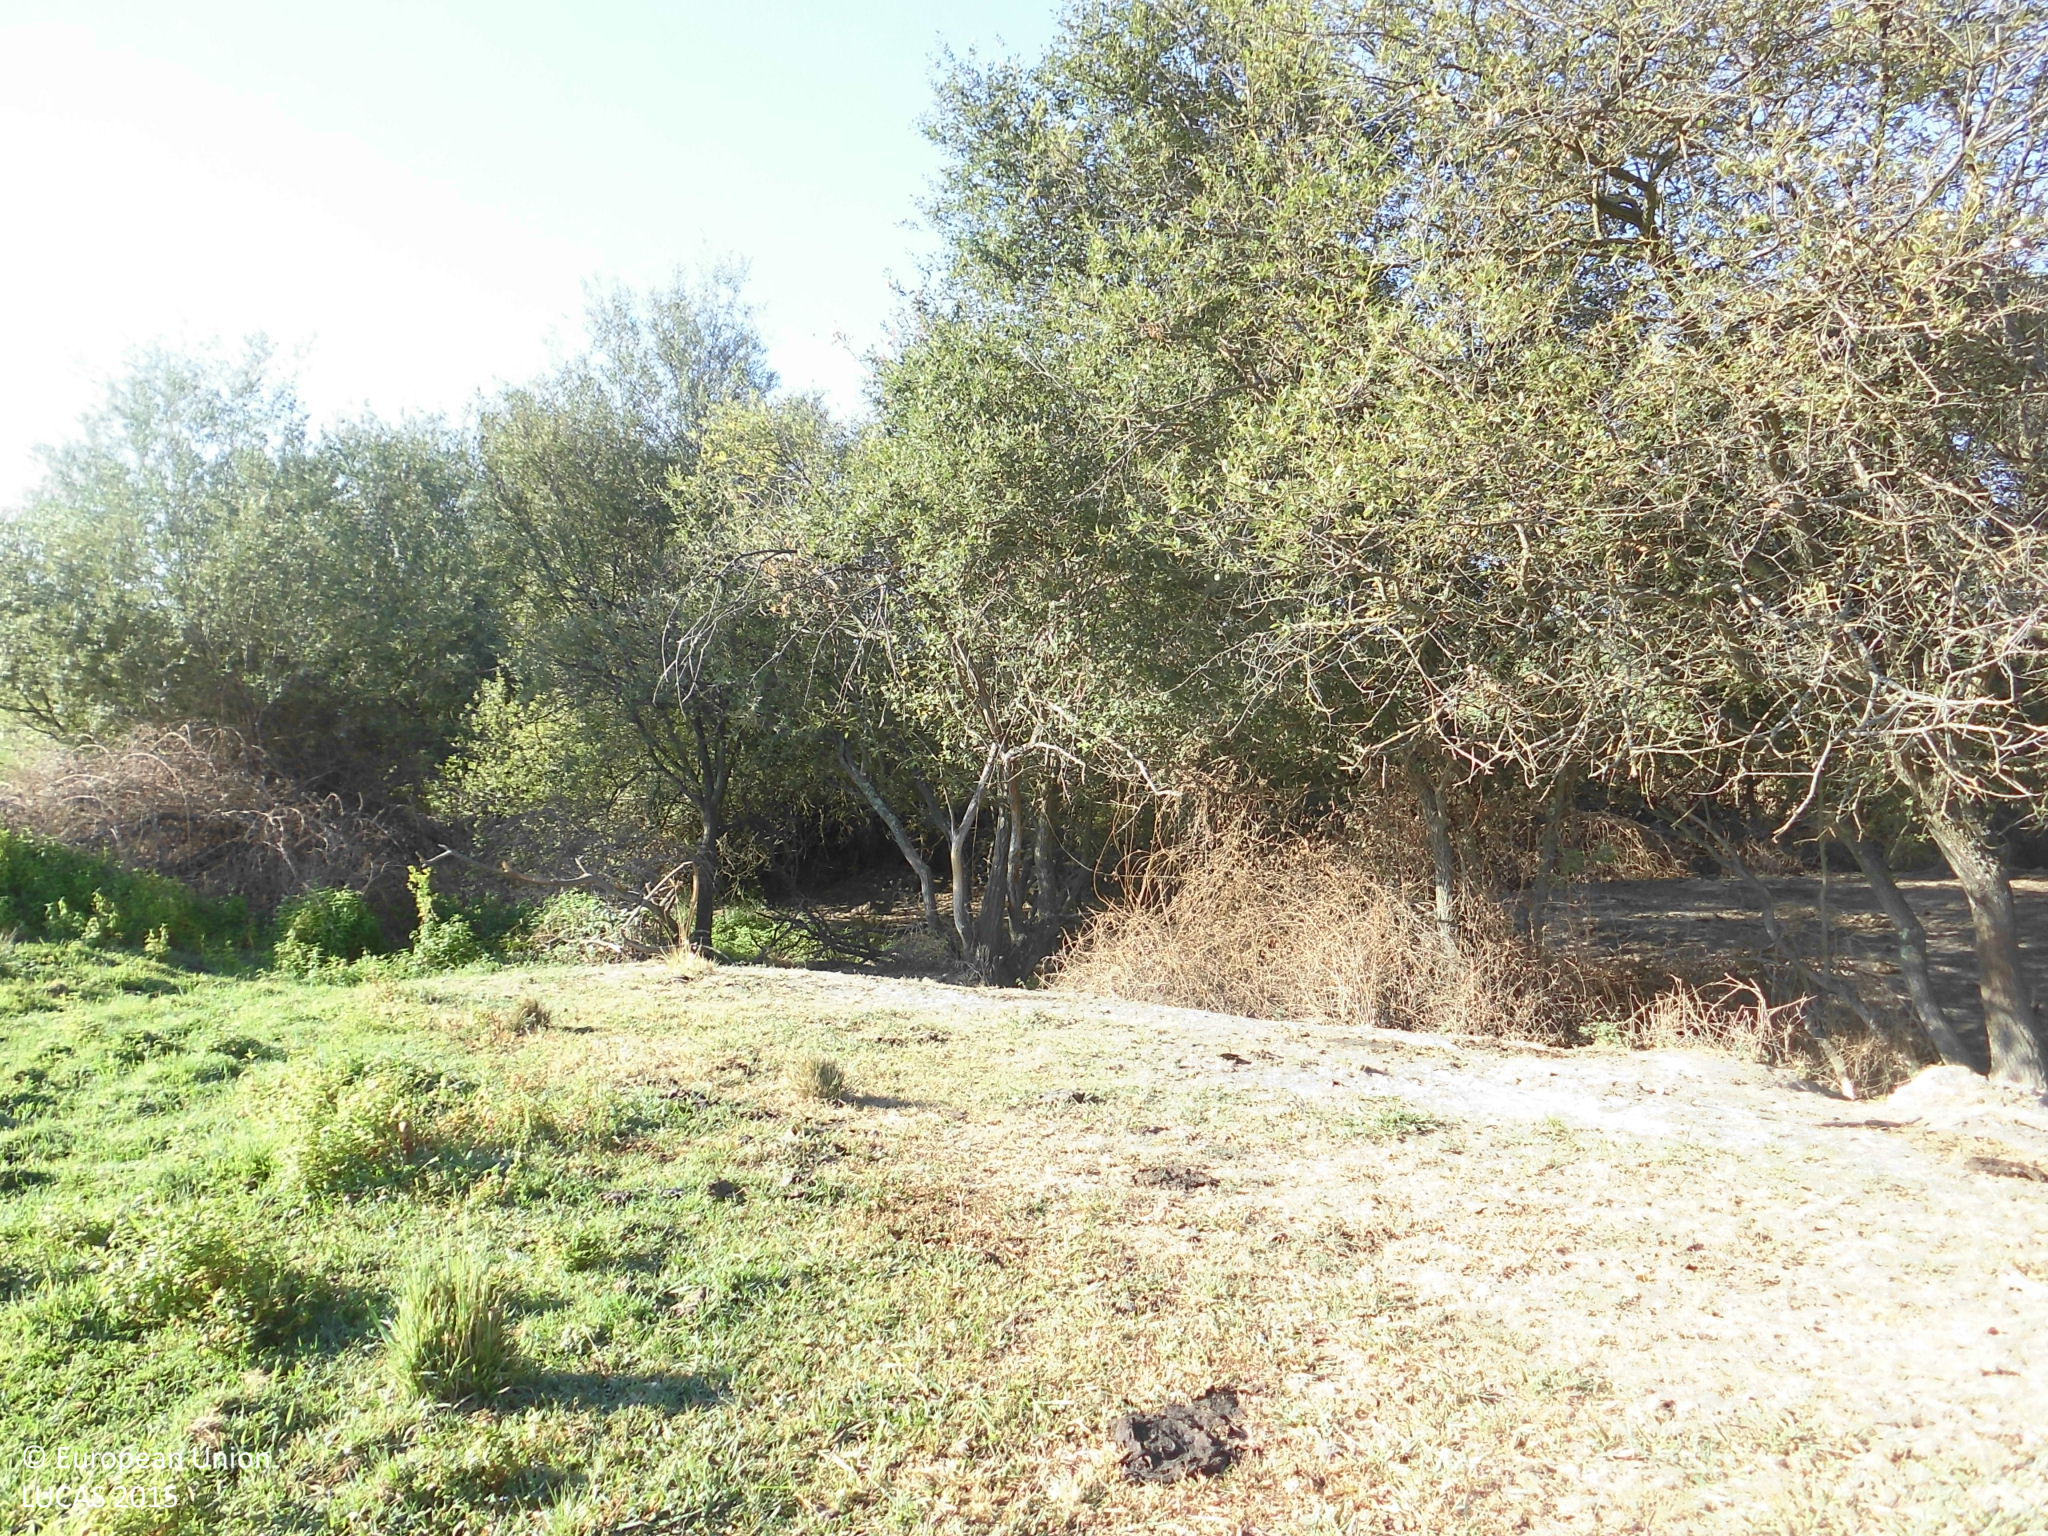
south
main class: Cropland
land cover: Temporary grasslands
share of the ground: > 75 %
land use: Agriculture (excluding fallow land and kitchen gardens)
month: July
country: ES
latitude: 40.0673
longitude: -6.2197
